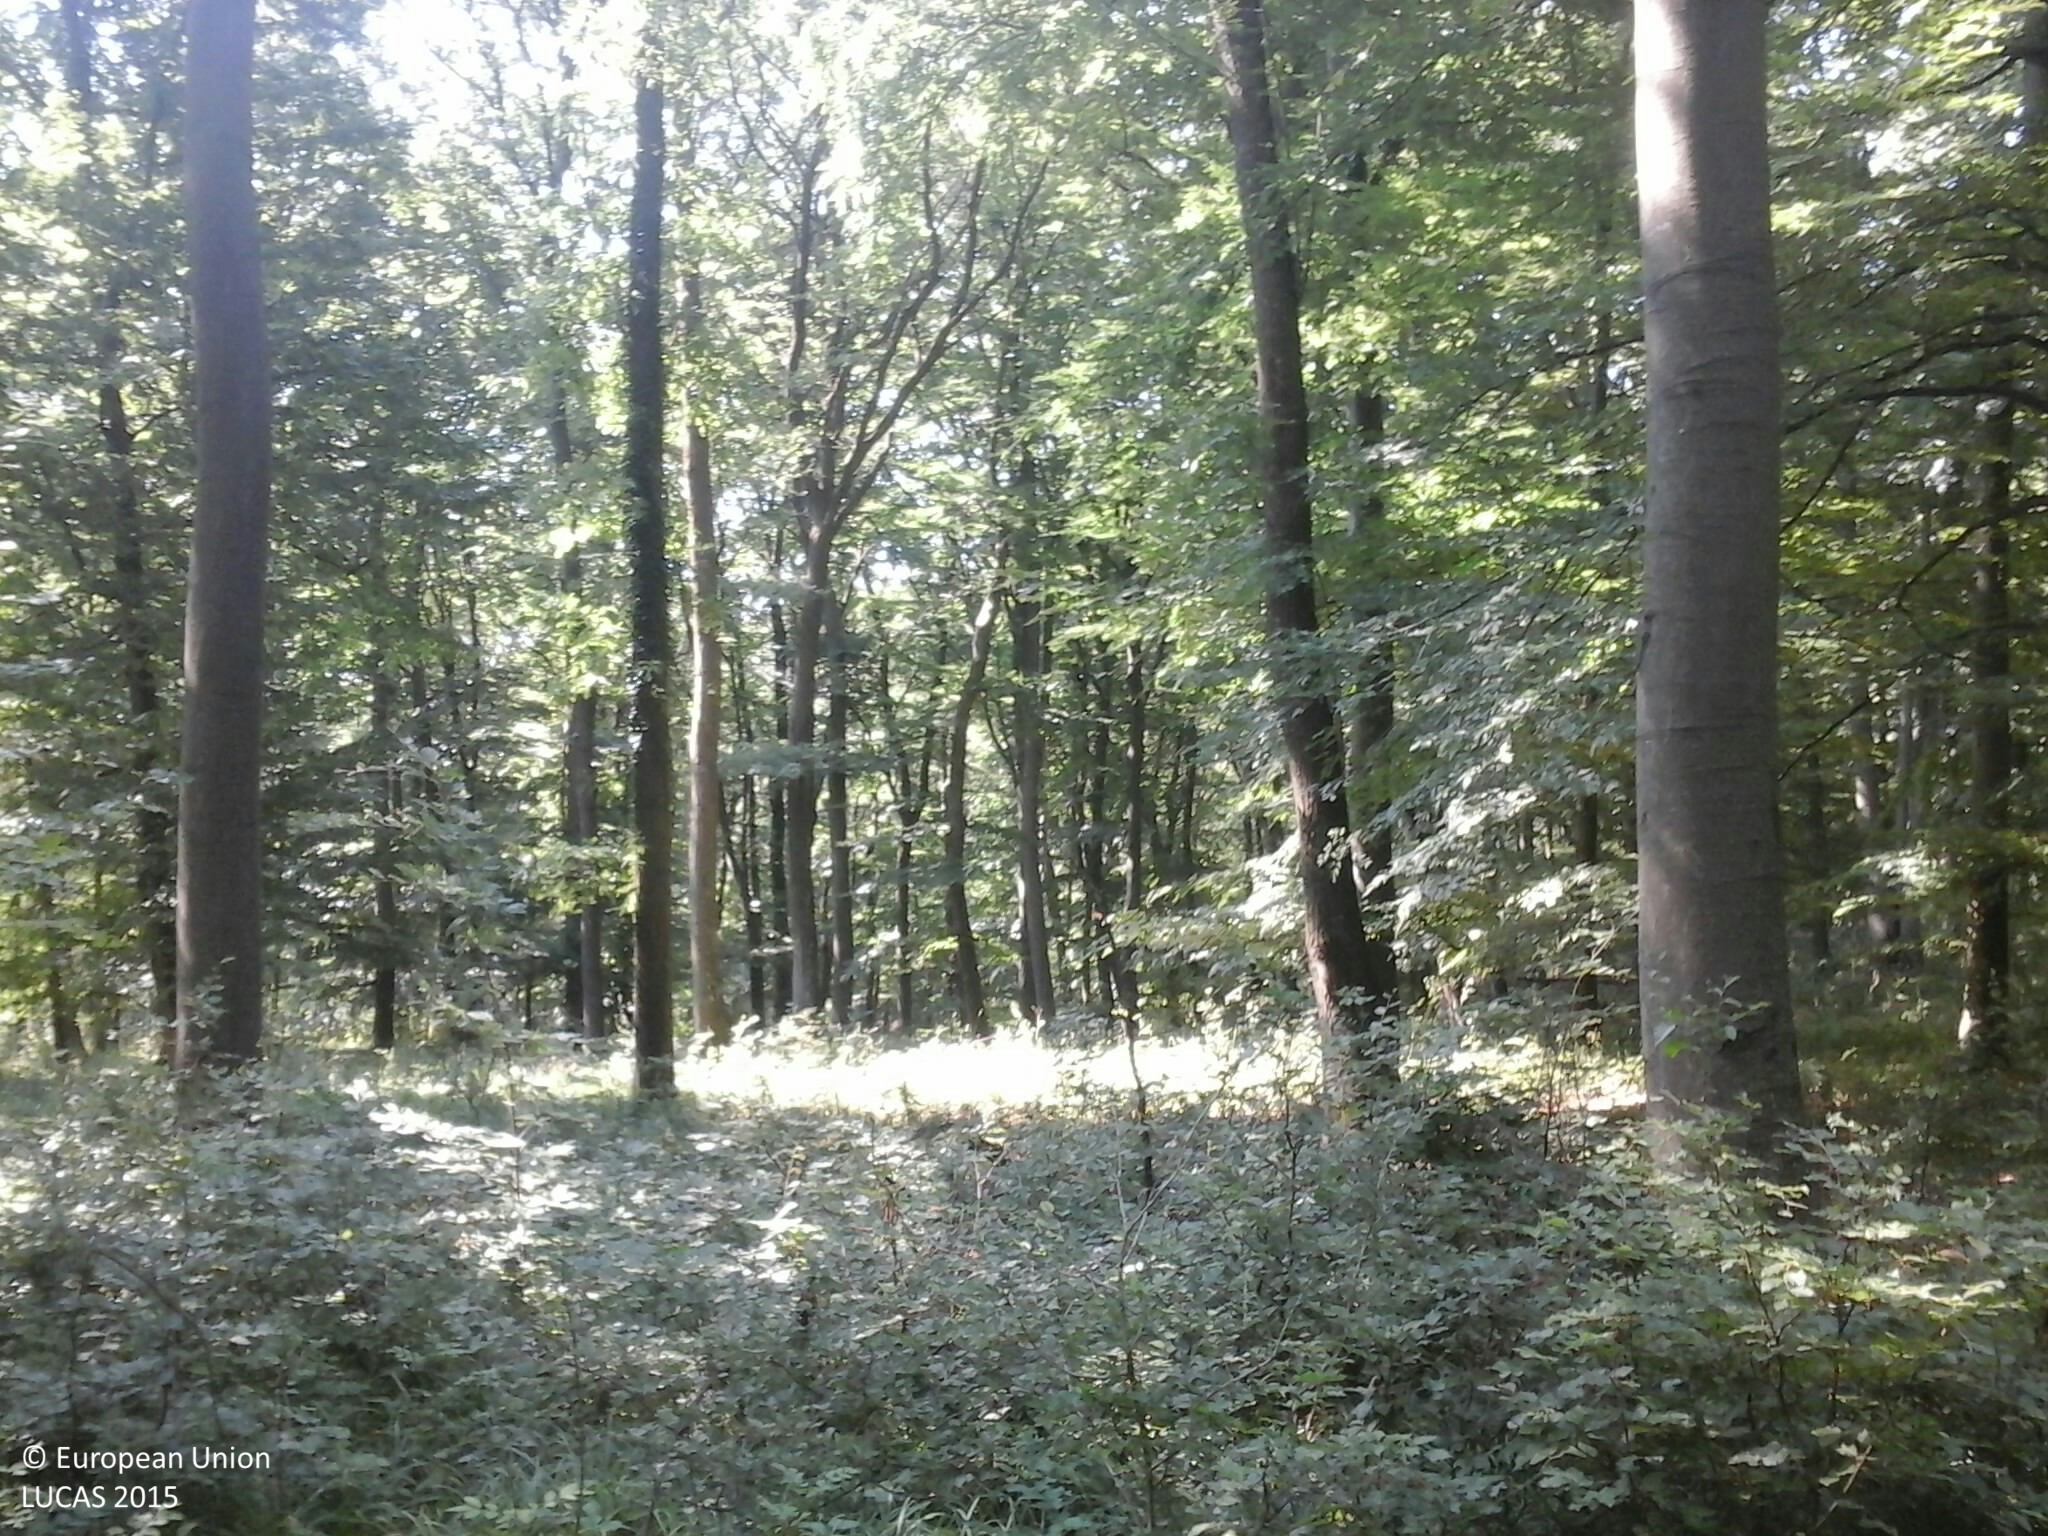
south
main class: Woodland
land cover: Broadleaved woodland
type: beech forest
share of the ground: > 75 %
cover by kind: broadleaved forest trees 95 %, herbaceous plants 5 %
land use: Forestry
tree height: > 5 m
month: July
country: HU
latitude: 47.1672
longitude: 17.8318
